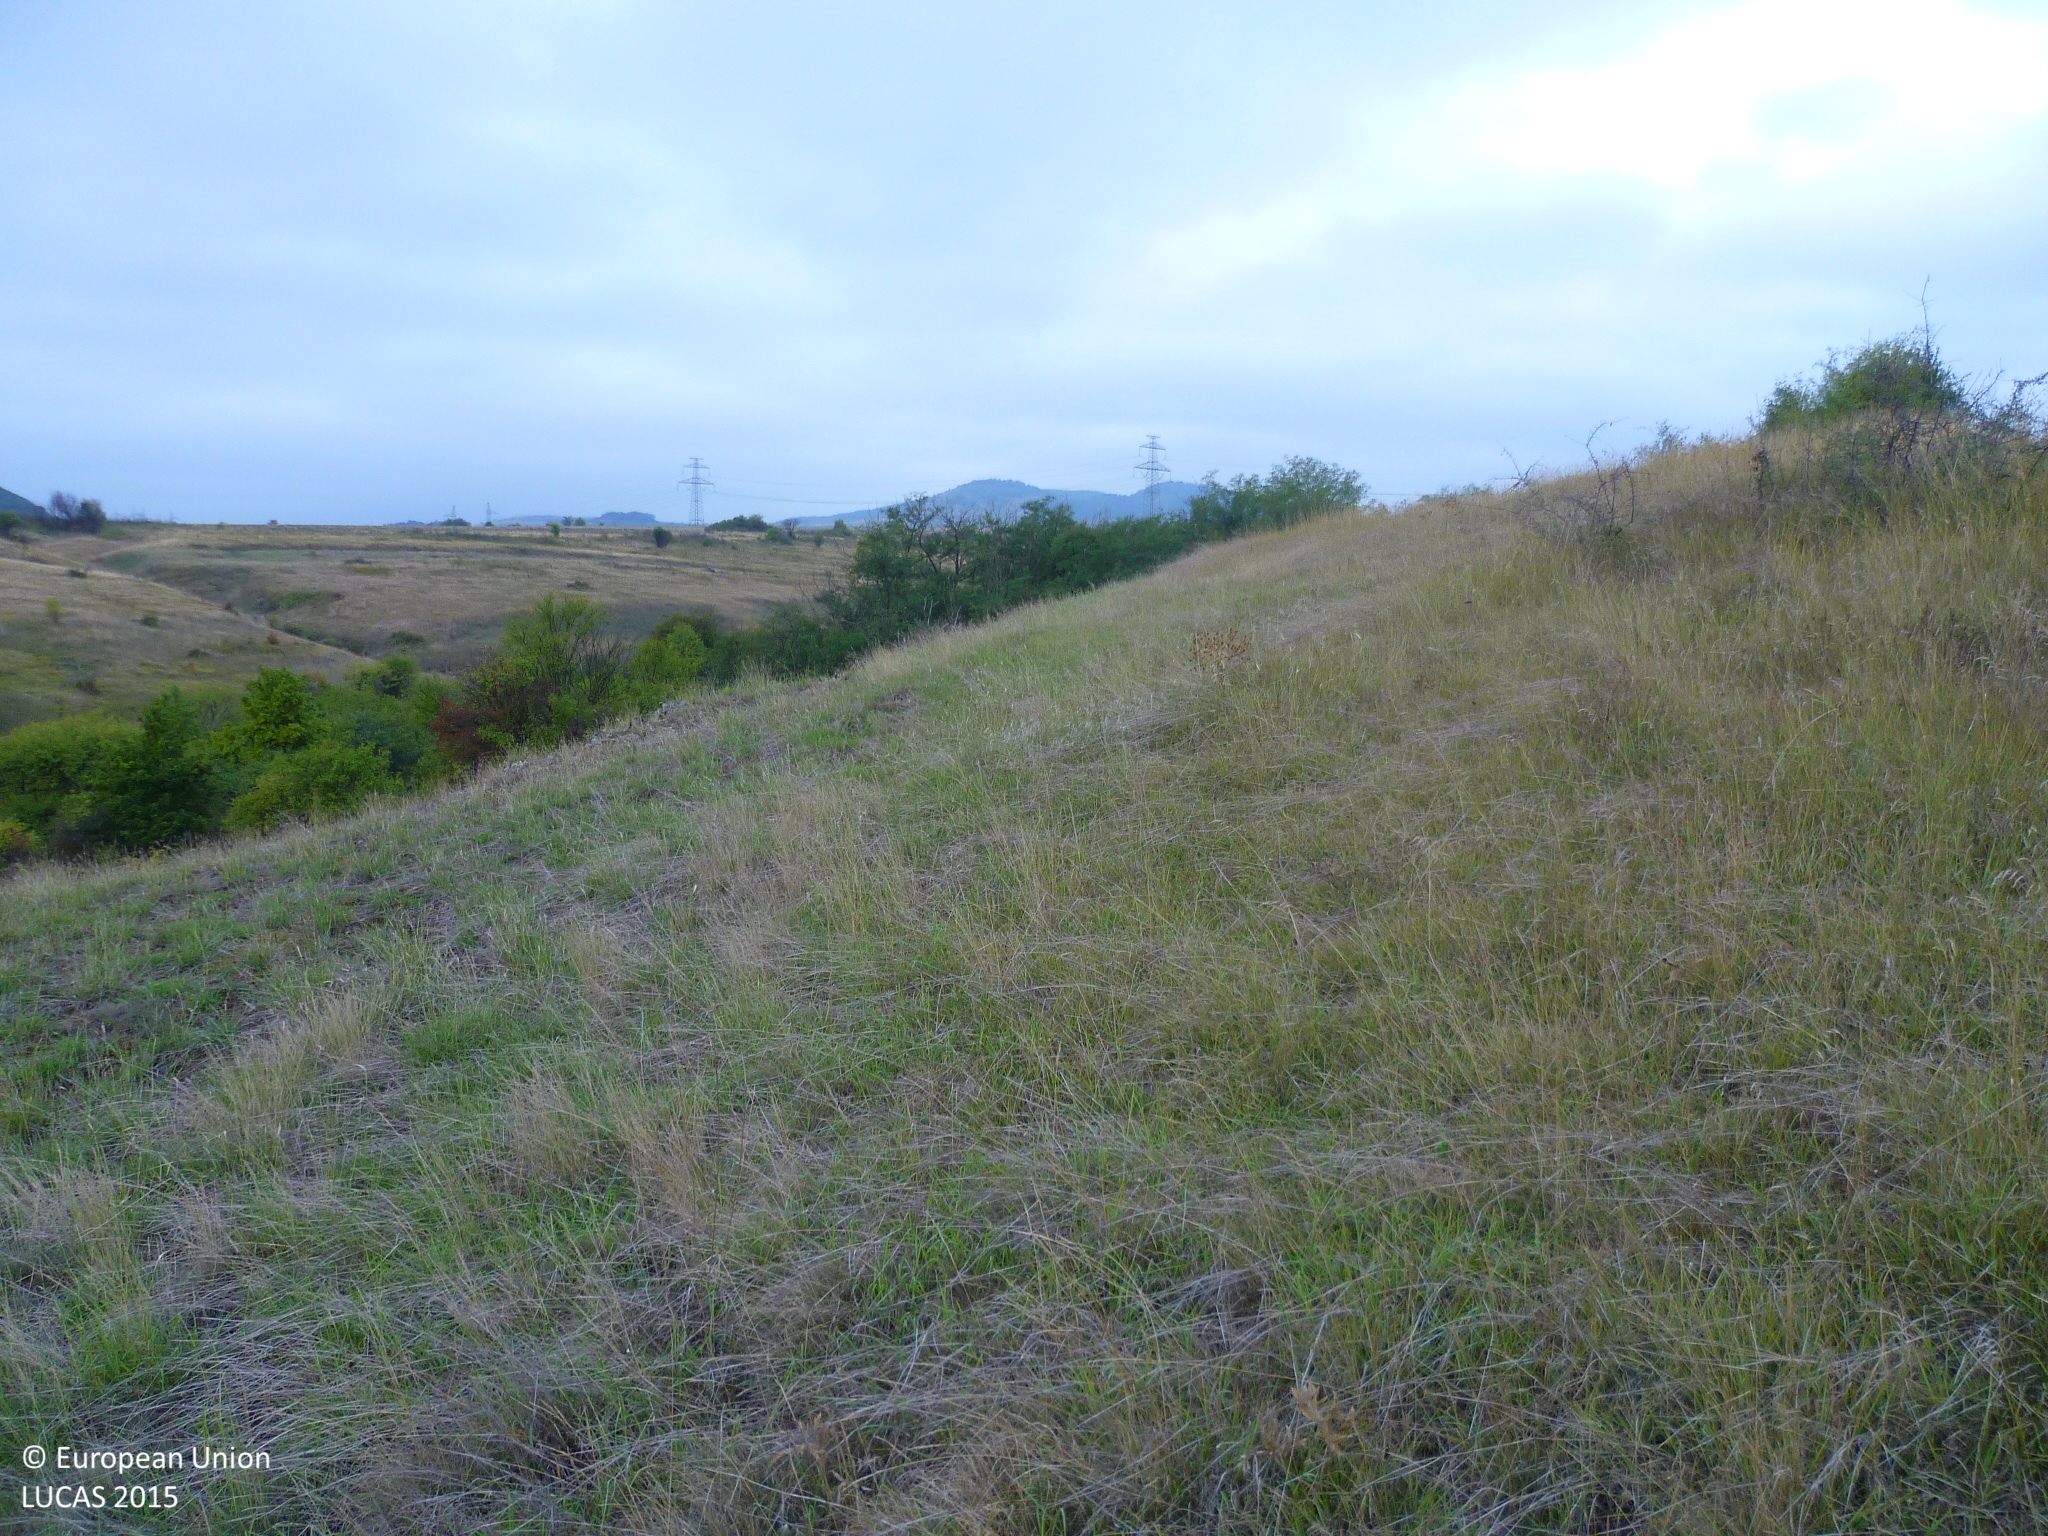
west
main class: Grassland
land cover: Grassland without tree/shrub cover
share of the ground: > 75 %
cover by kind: herbaceous plants 100 %
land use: Agriculture (excluding fallow land and kitchen gardens)
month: September
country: BG
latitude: 42.7888
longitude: 23.0757
